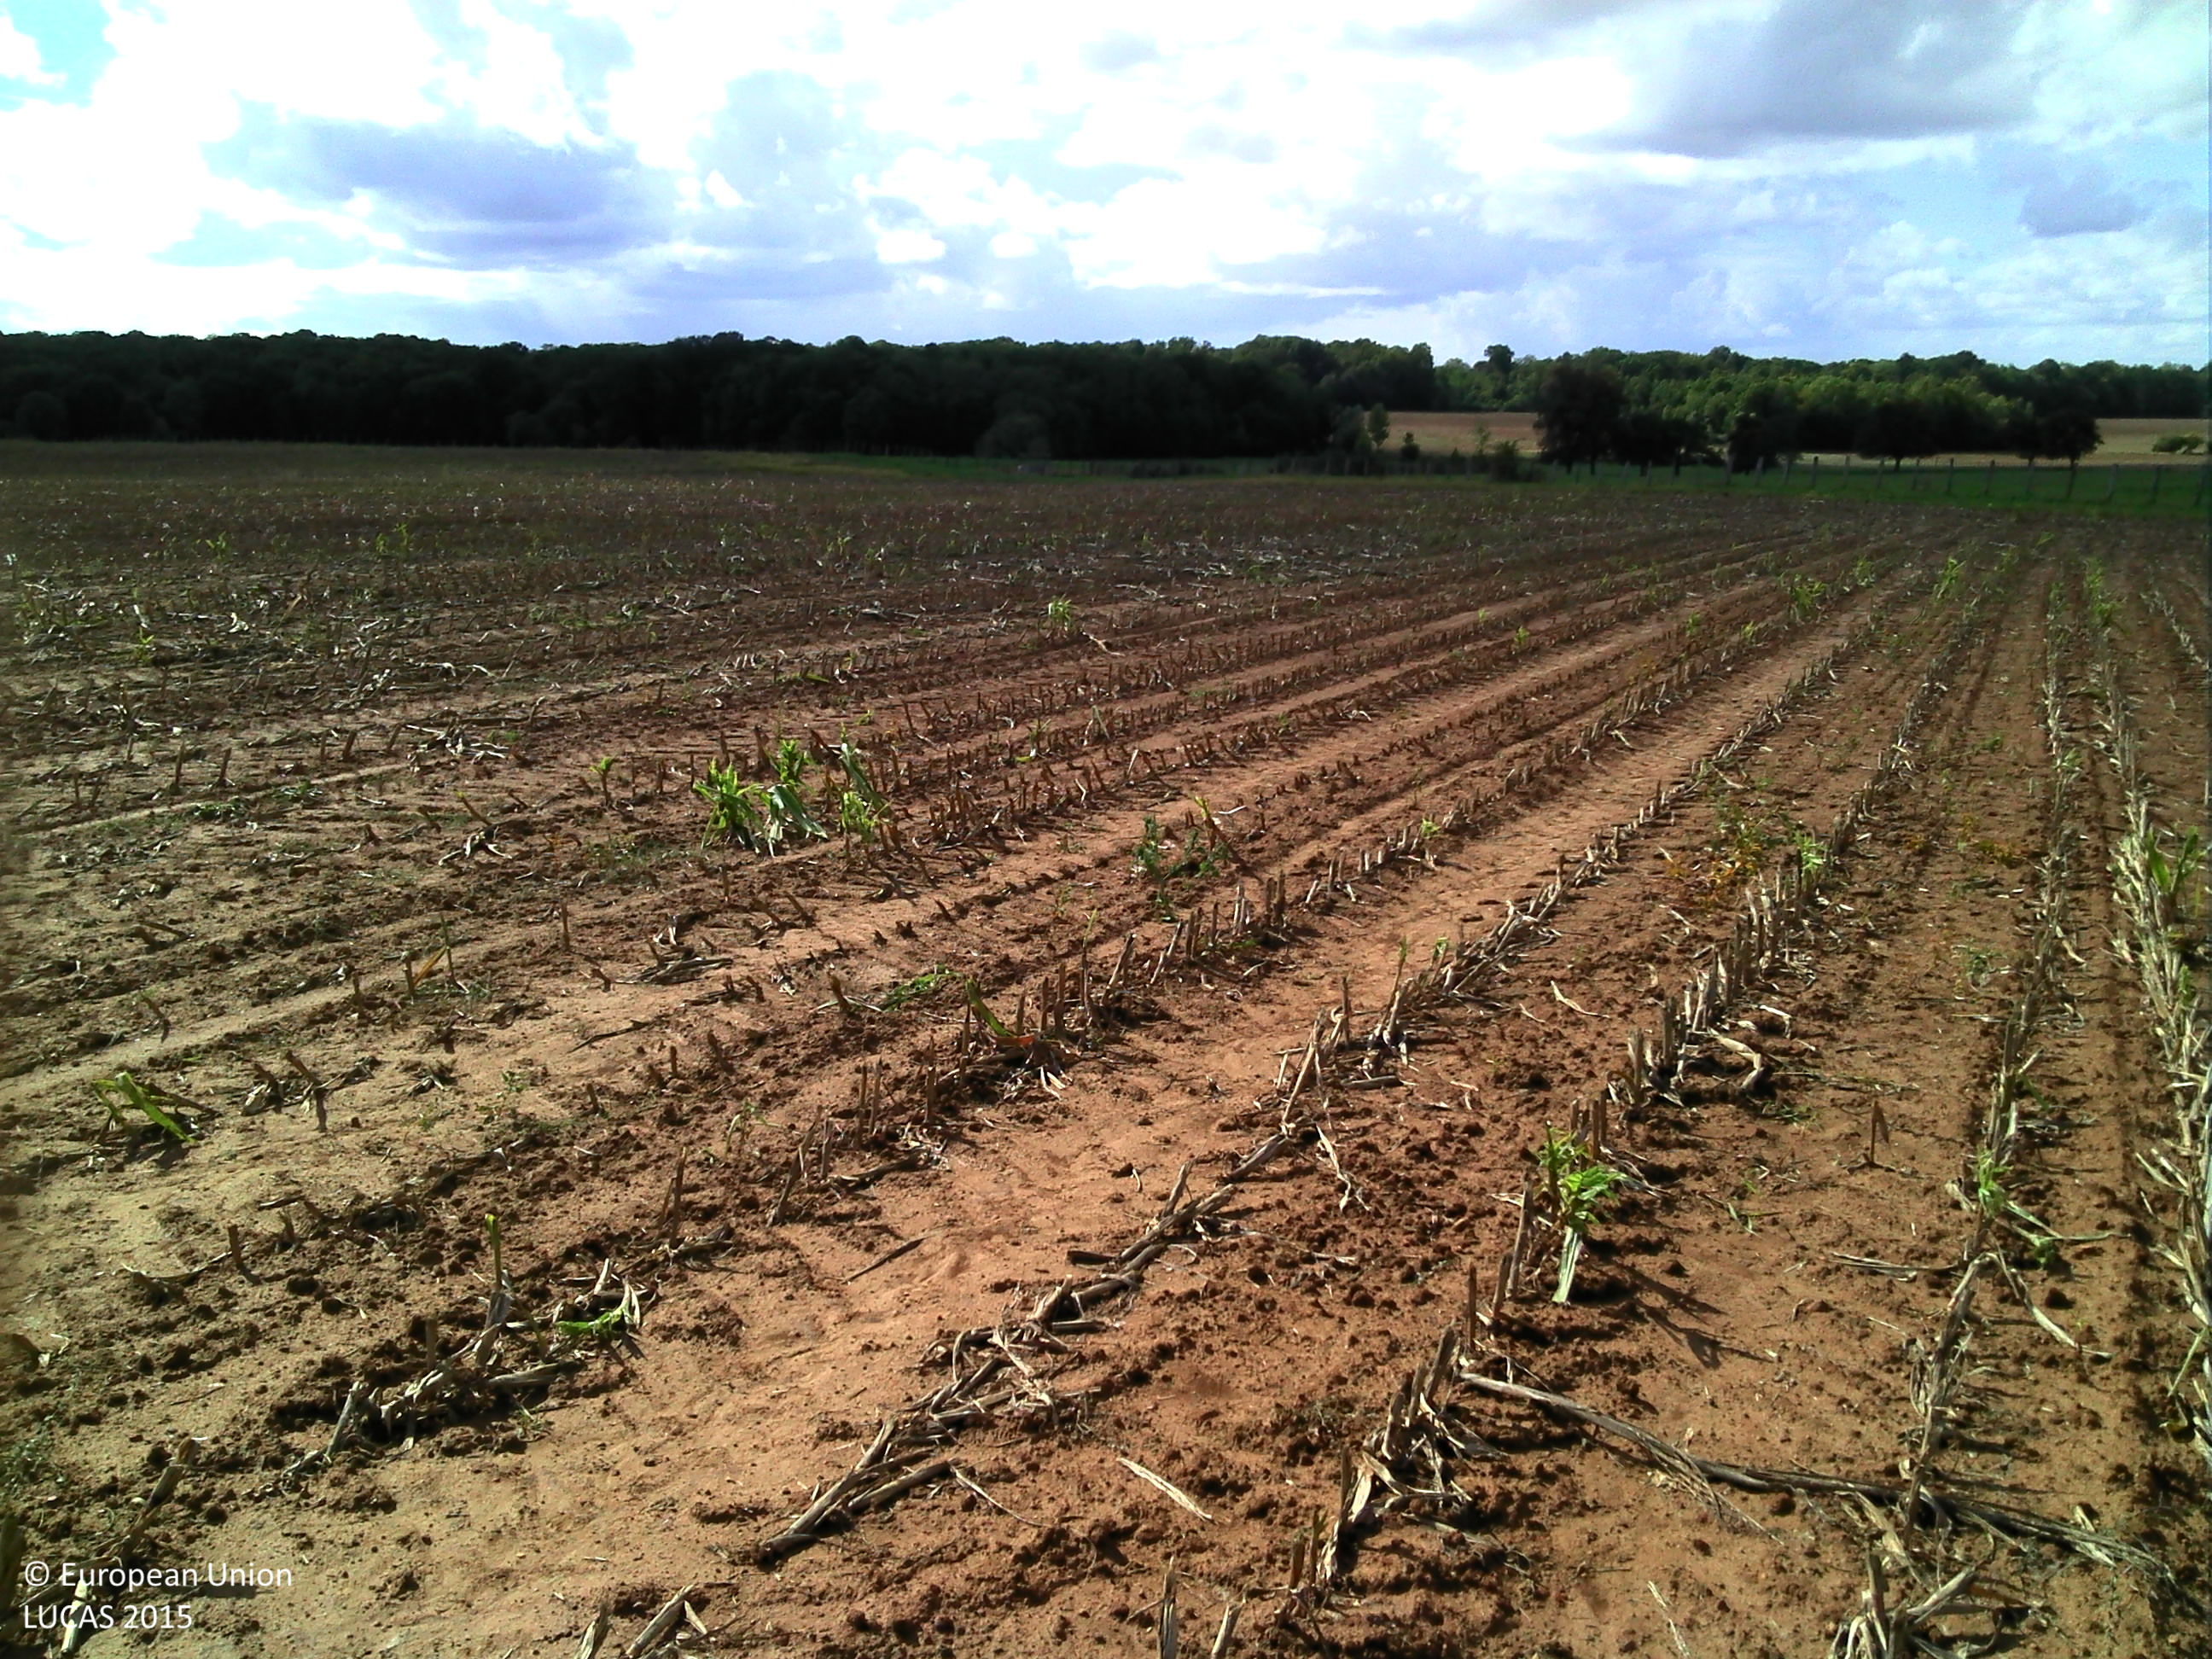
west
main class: Cropland
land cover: Maize
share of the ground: < 10 %
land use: Agriculture (excluding fallow land and kitchen gardens)
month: September
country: FR
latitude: 48.3675
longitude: 4.7200
